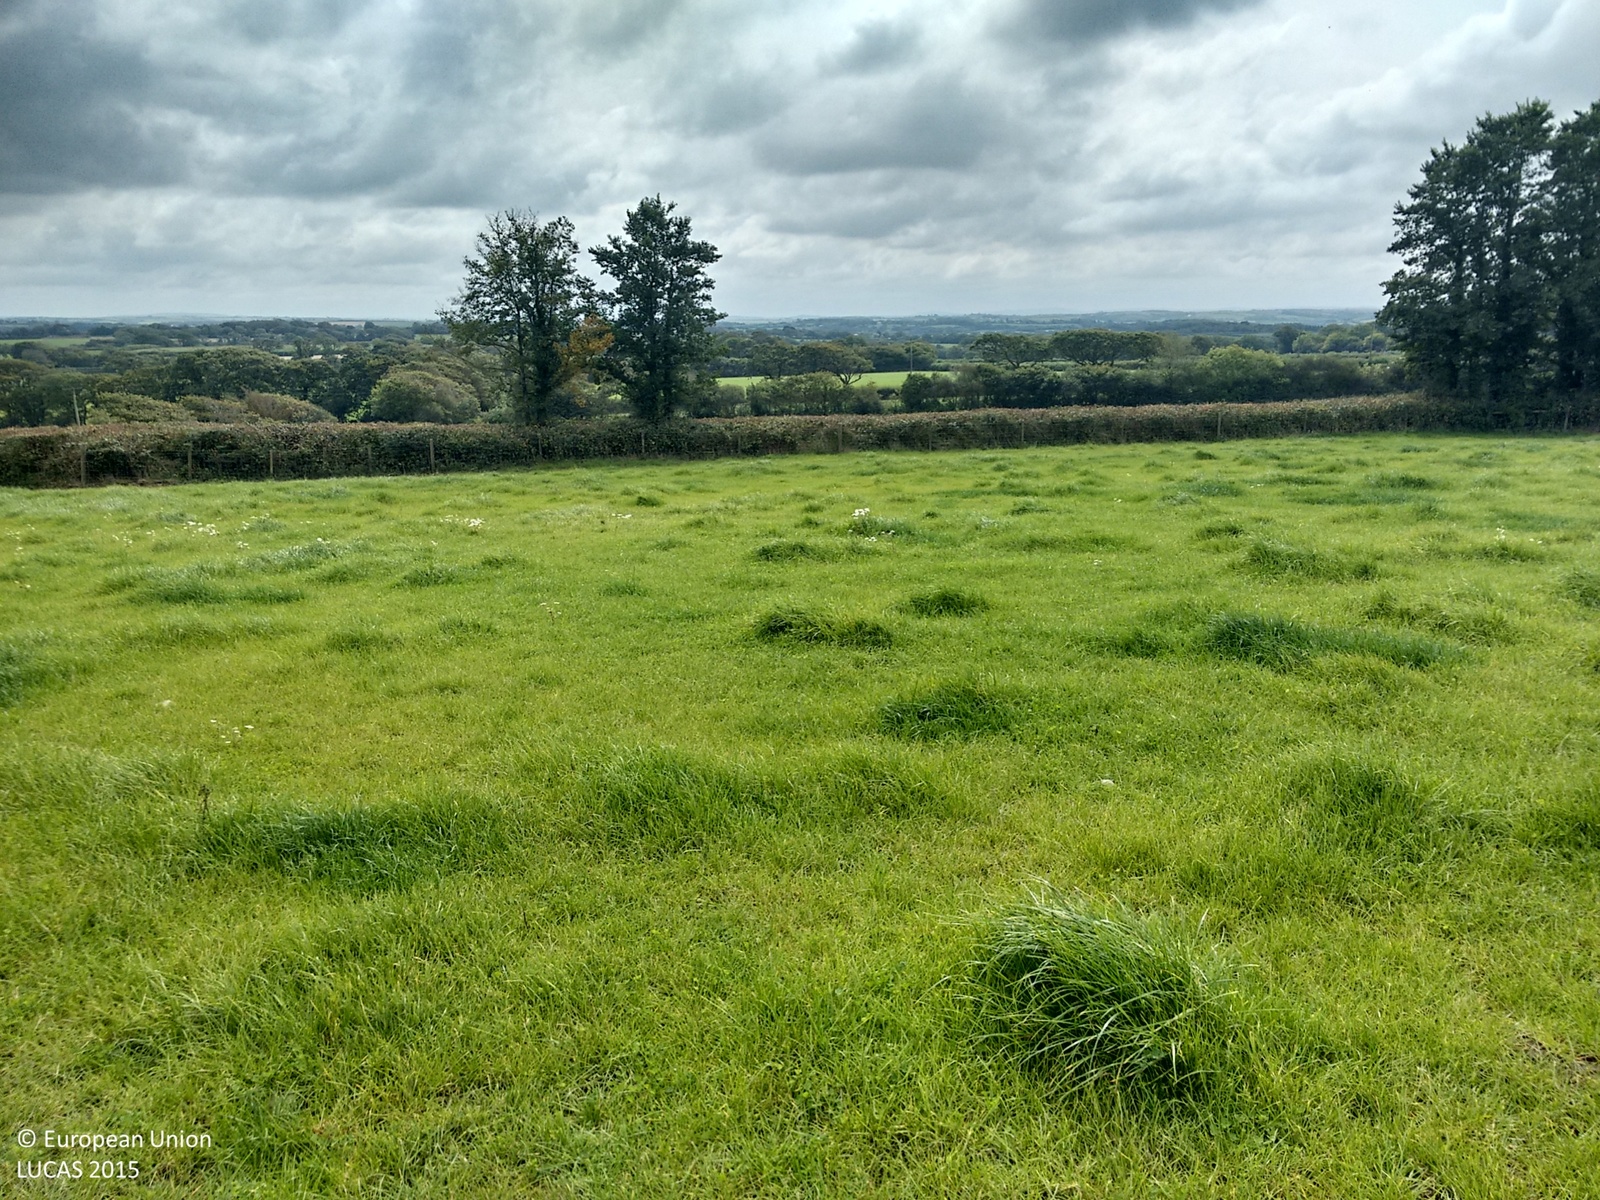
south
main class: Grassland
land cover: Grassland without tree/shrub cover
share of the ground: > 75 %
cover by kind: herbaceous plants 100 %
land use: Agriculture (excluding fallow land and kitchen gardens)
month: September
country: GB
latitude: 50.8000
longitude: -4.3903
